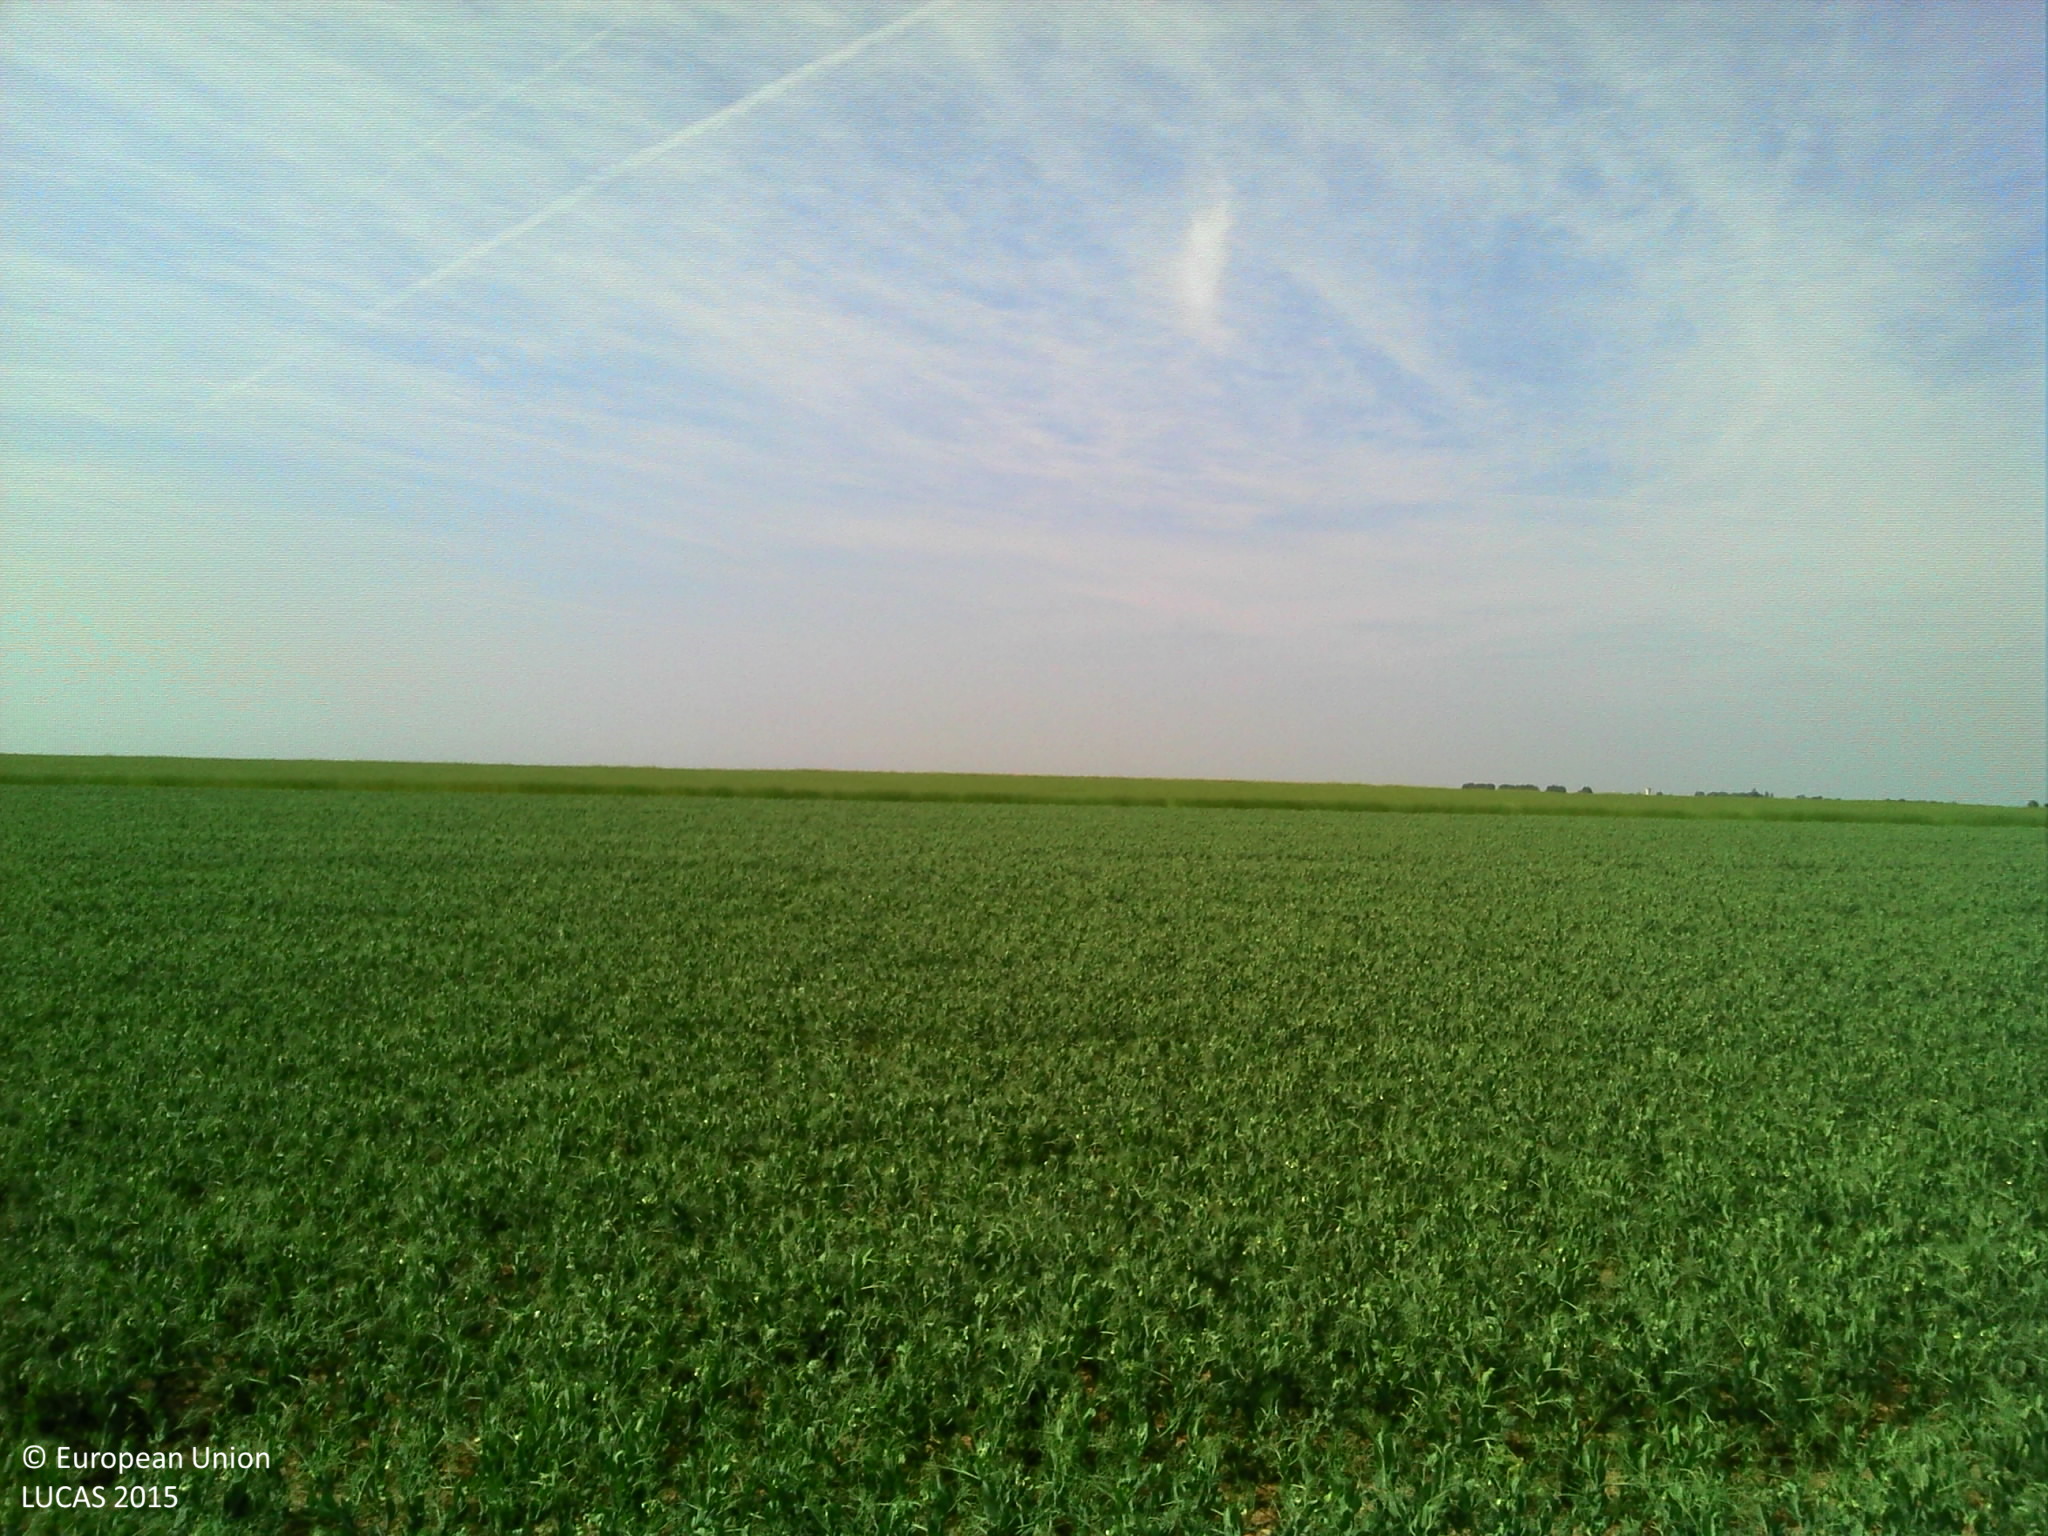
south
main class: Cropland
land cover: Dry pulses
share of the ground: > 75 %
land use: Agriculture (excluding fallow land and kitchen gardens)
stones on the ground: < 10 %
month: June
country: FR
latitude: 49.5102
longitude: 2.5997
